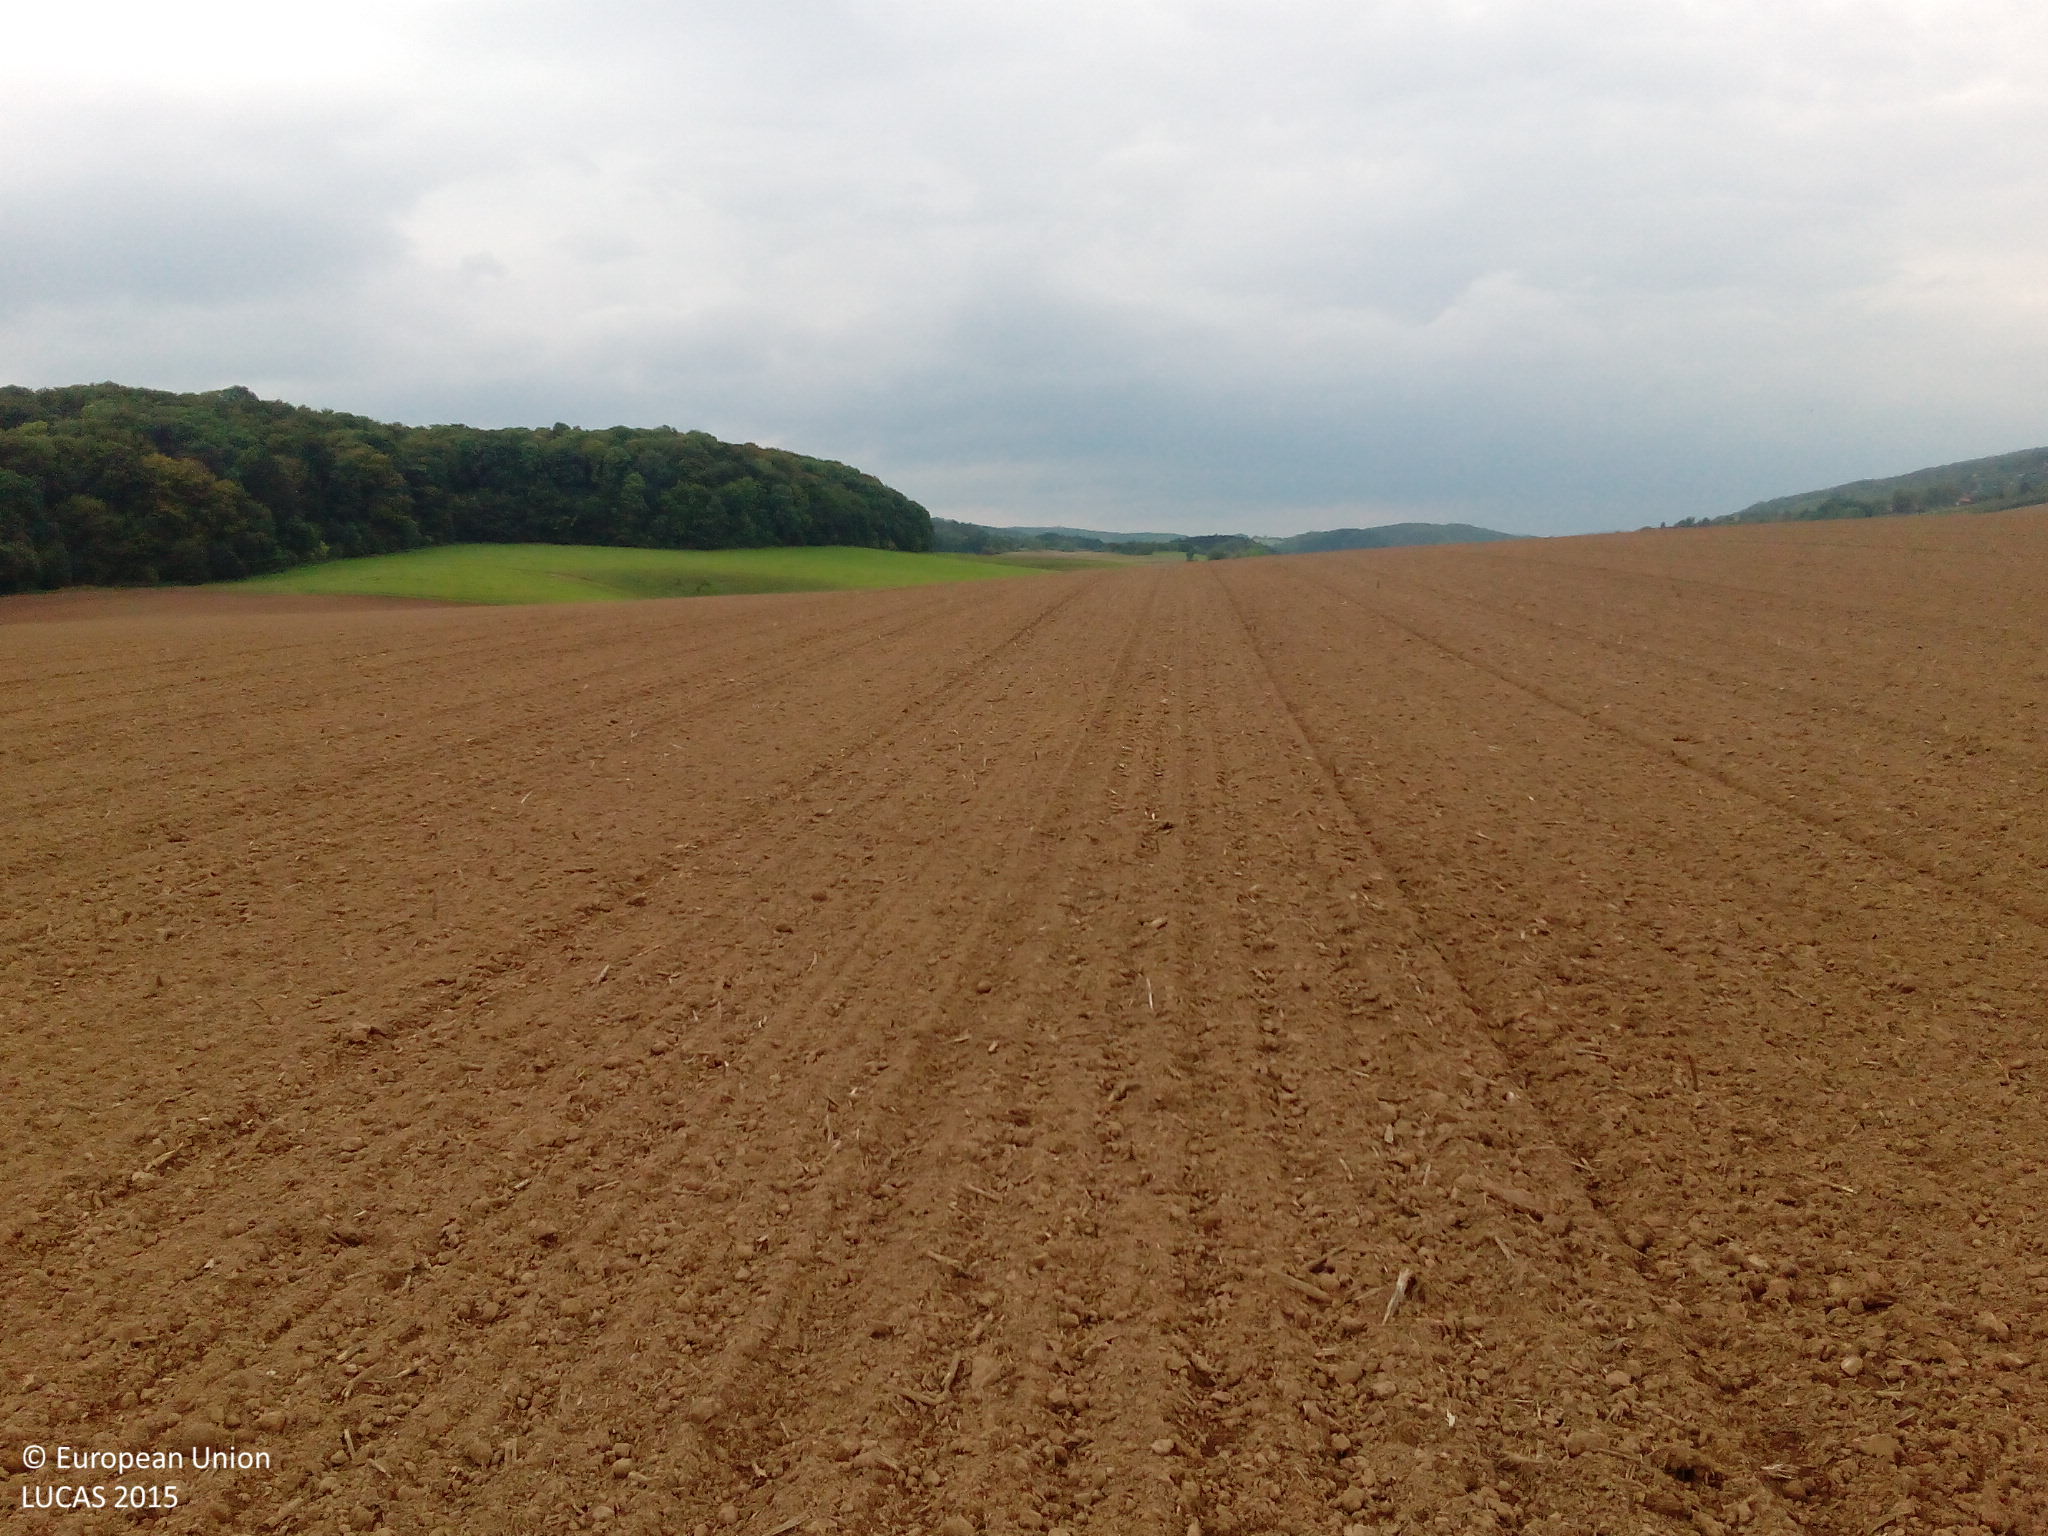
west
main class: Cropland
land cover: Rape and turnip rape
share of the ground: < 10 %
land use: Agriculture (excluding fallow land and kitchen gardens)
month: September
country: DE
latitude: 51.4917
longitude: 11.0799
